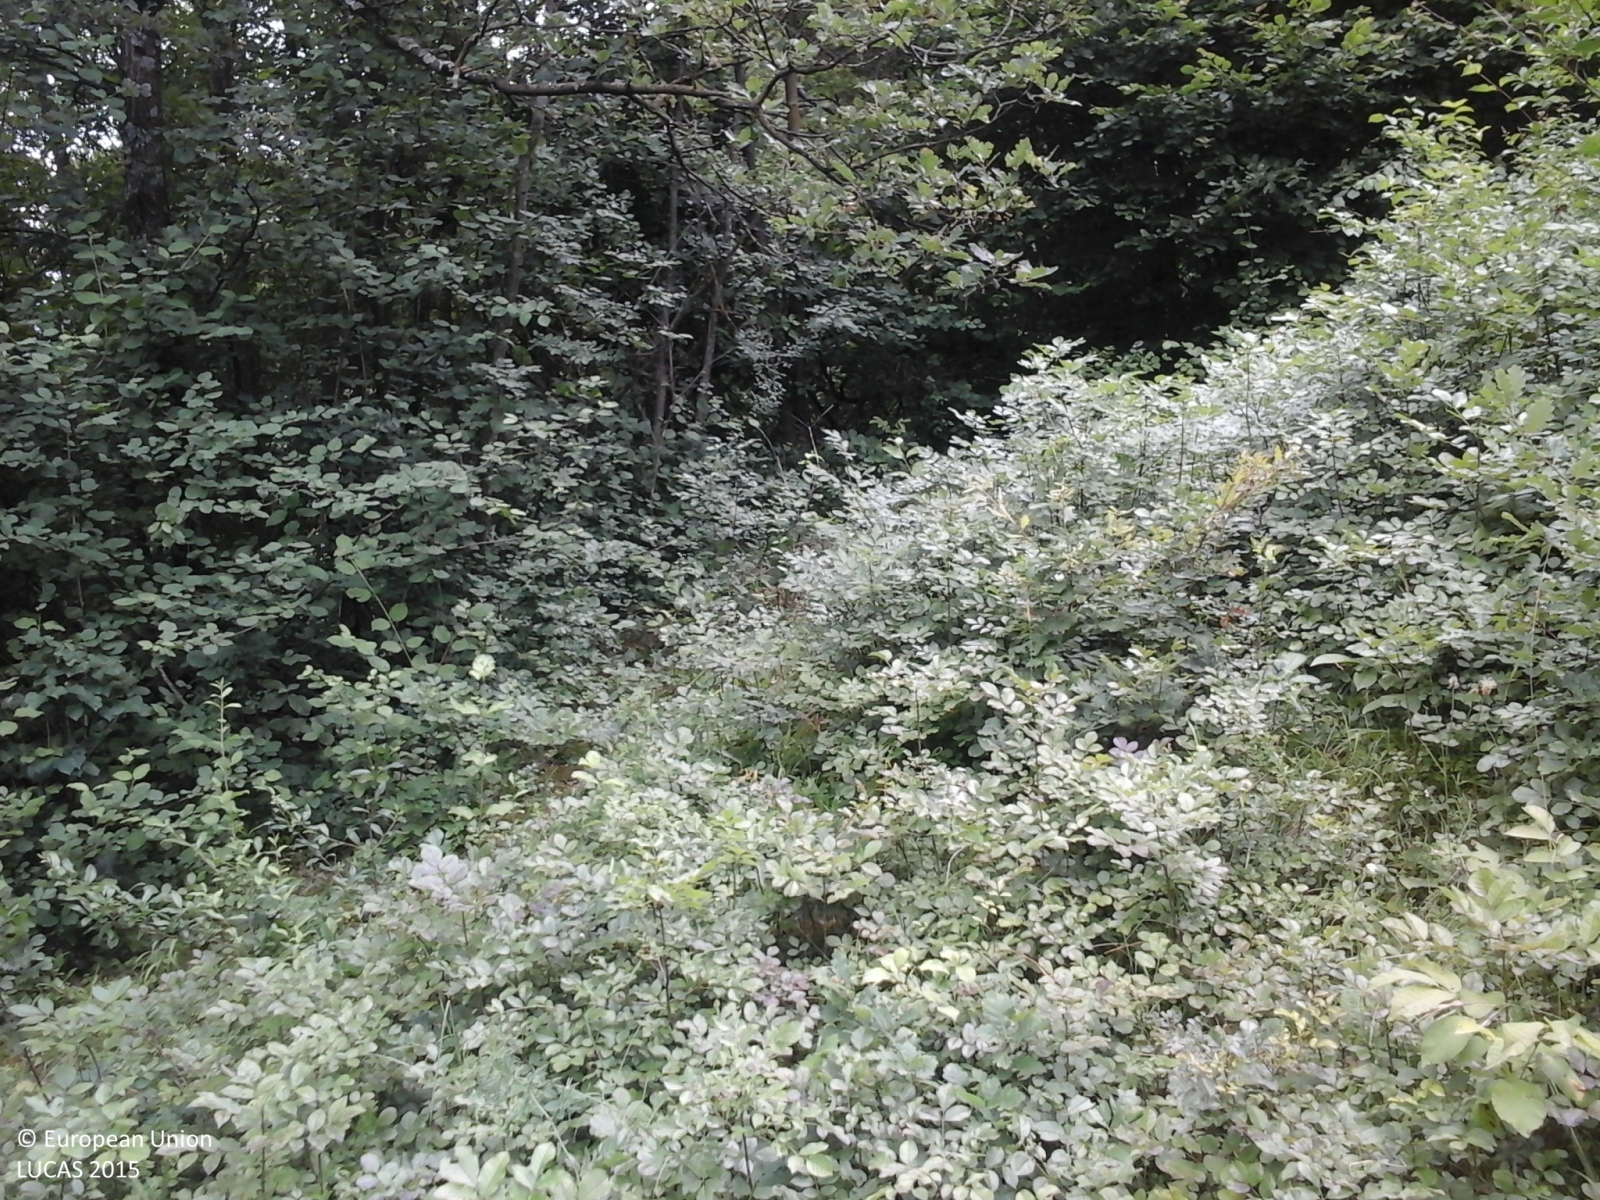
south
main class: Woodland
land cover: Broadleaved woodland
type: mesophytic deciduous forest
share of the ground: > 75 %
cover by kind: broadleaved forest trees 100 %
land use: Forestry
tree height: > 5 m
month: June
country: IT
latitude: 46.6634
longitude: 11.6057
